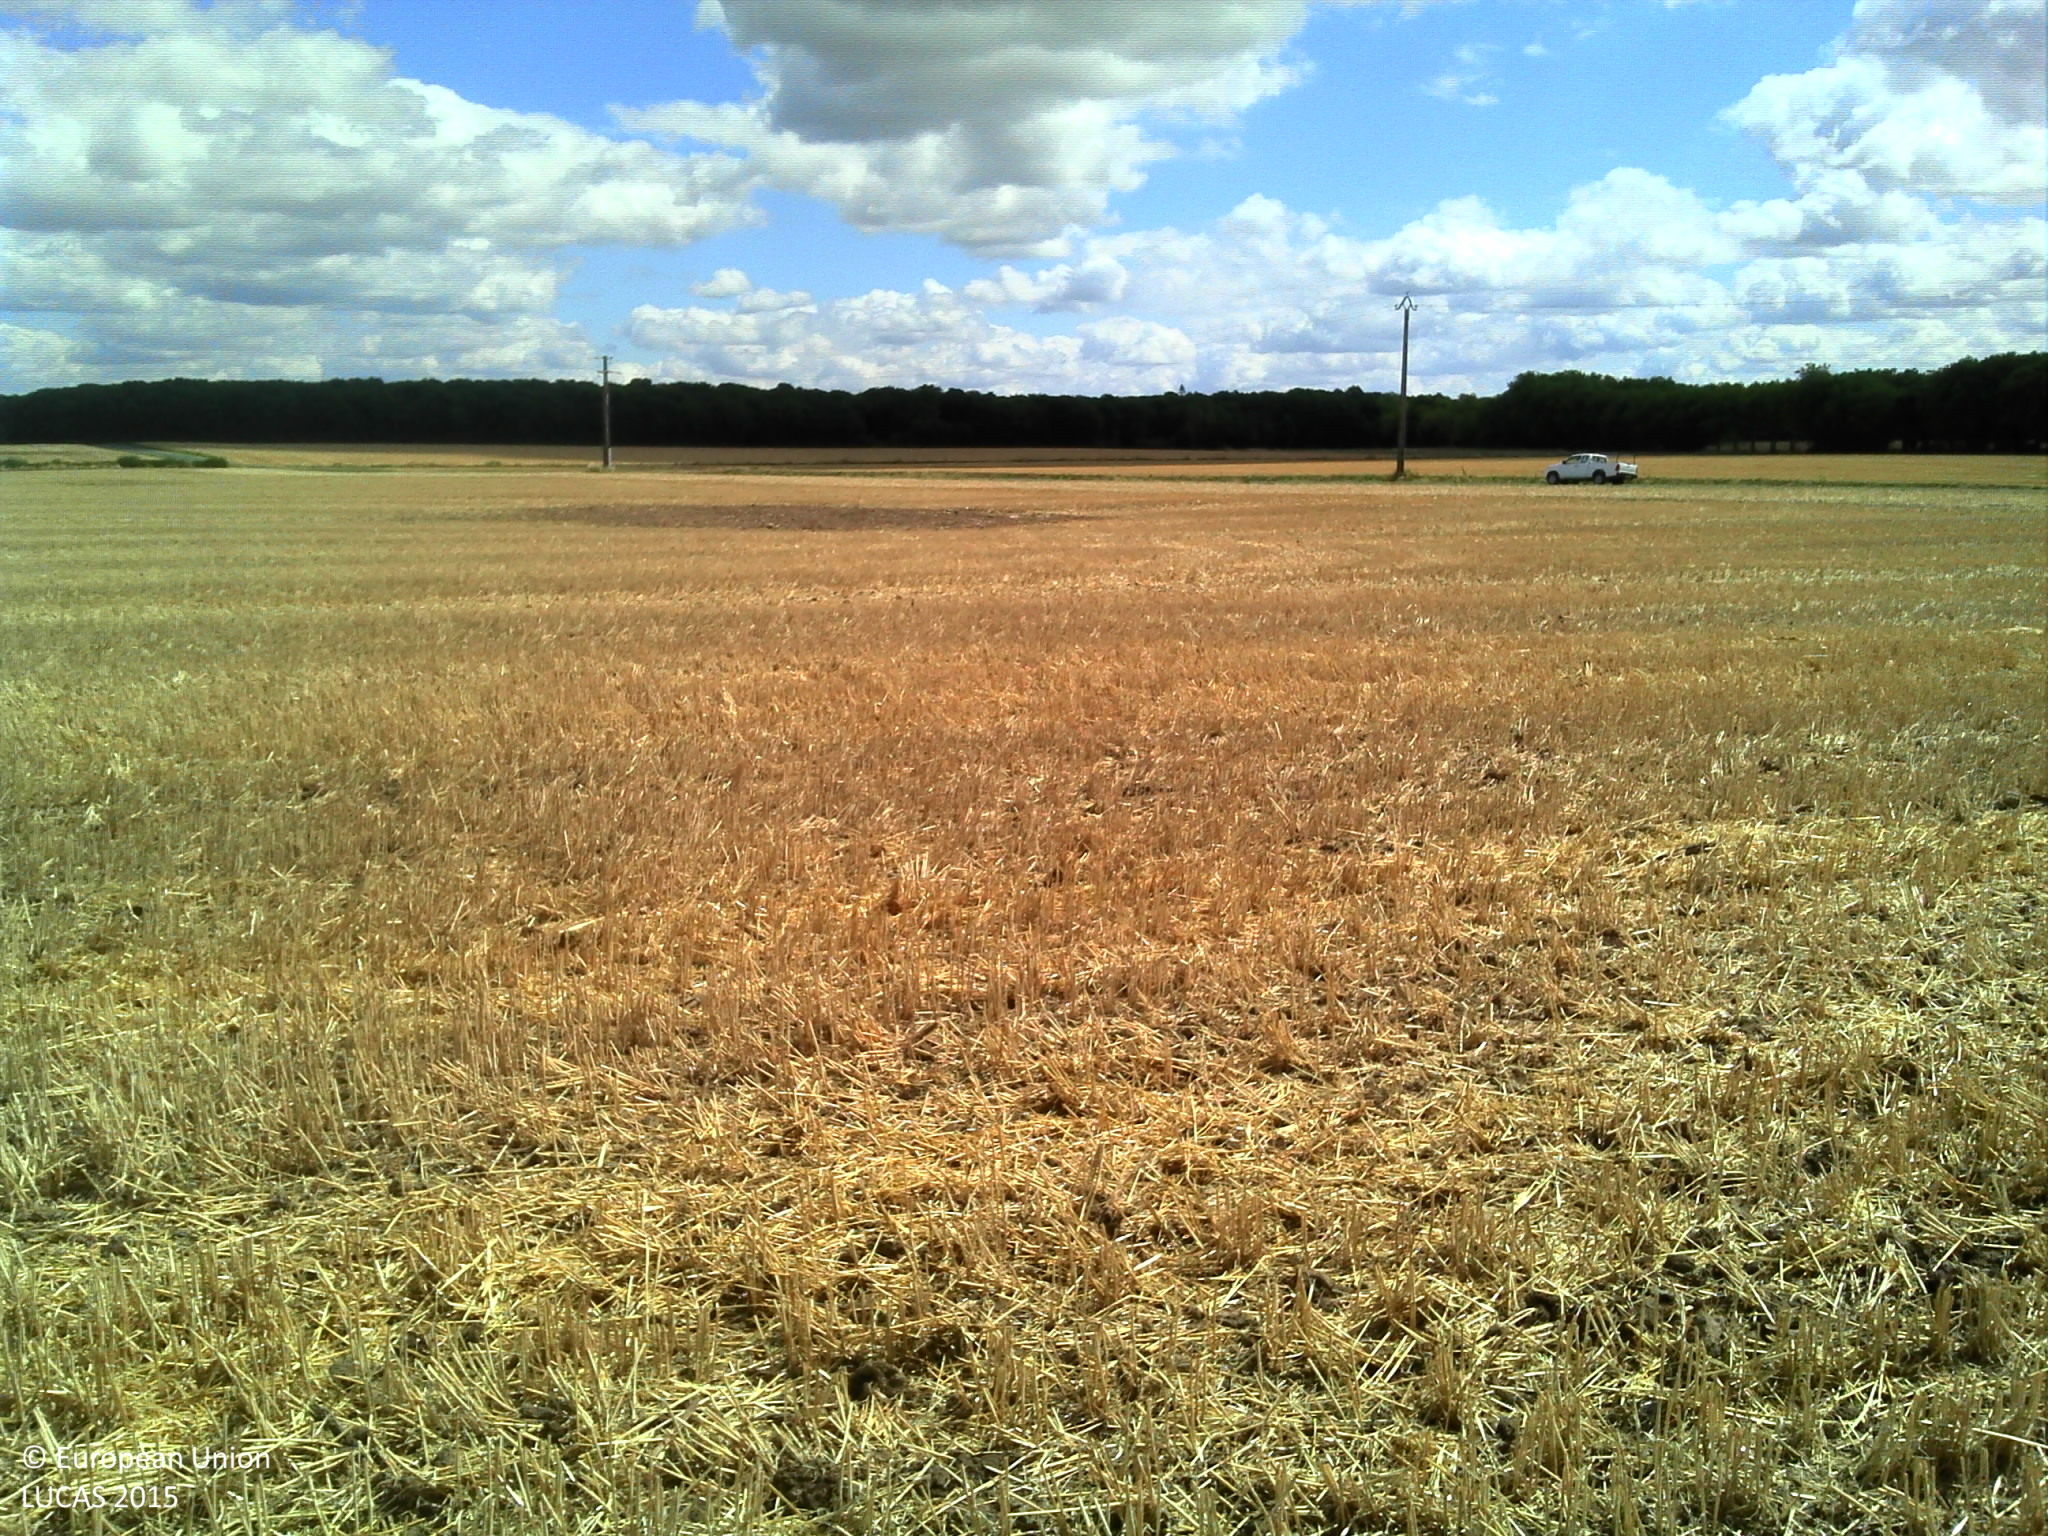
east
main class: Cropland
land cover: Common wheat
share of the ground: > 75 %
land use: Agriculture (excluding fallow land and kitchen gardens)
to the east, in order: Common wheat; Grass margins; Ditches and canals; Grass margins; Paved roads, cycling and walking lanes; Grass margins; Ditches and canals; Electric lines; Grass margins; Common wheat
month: August
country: FR
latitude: 47.1436
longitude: 2.0922
